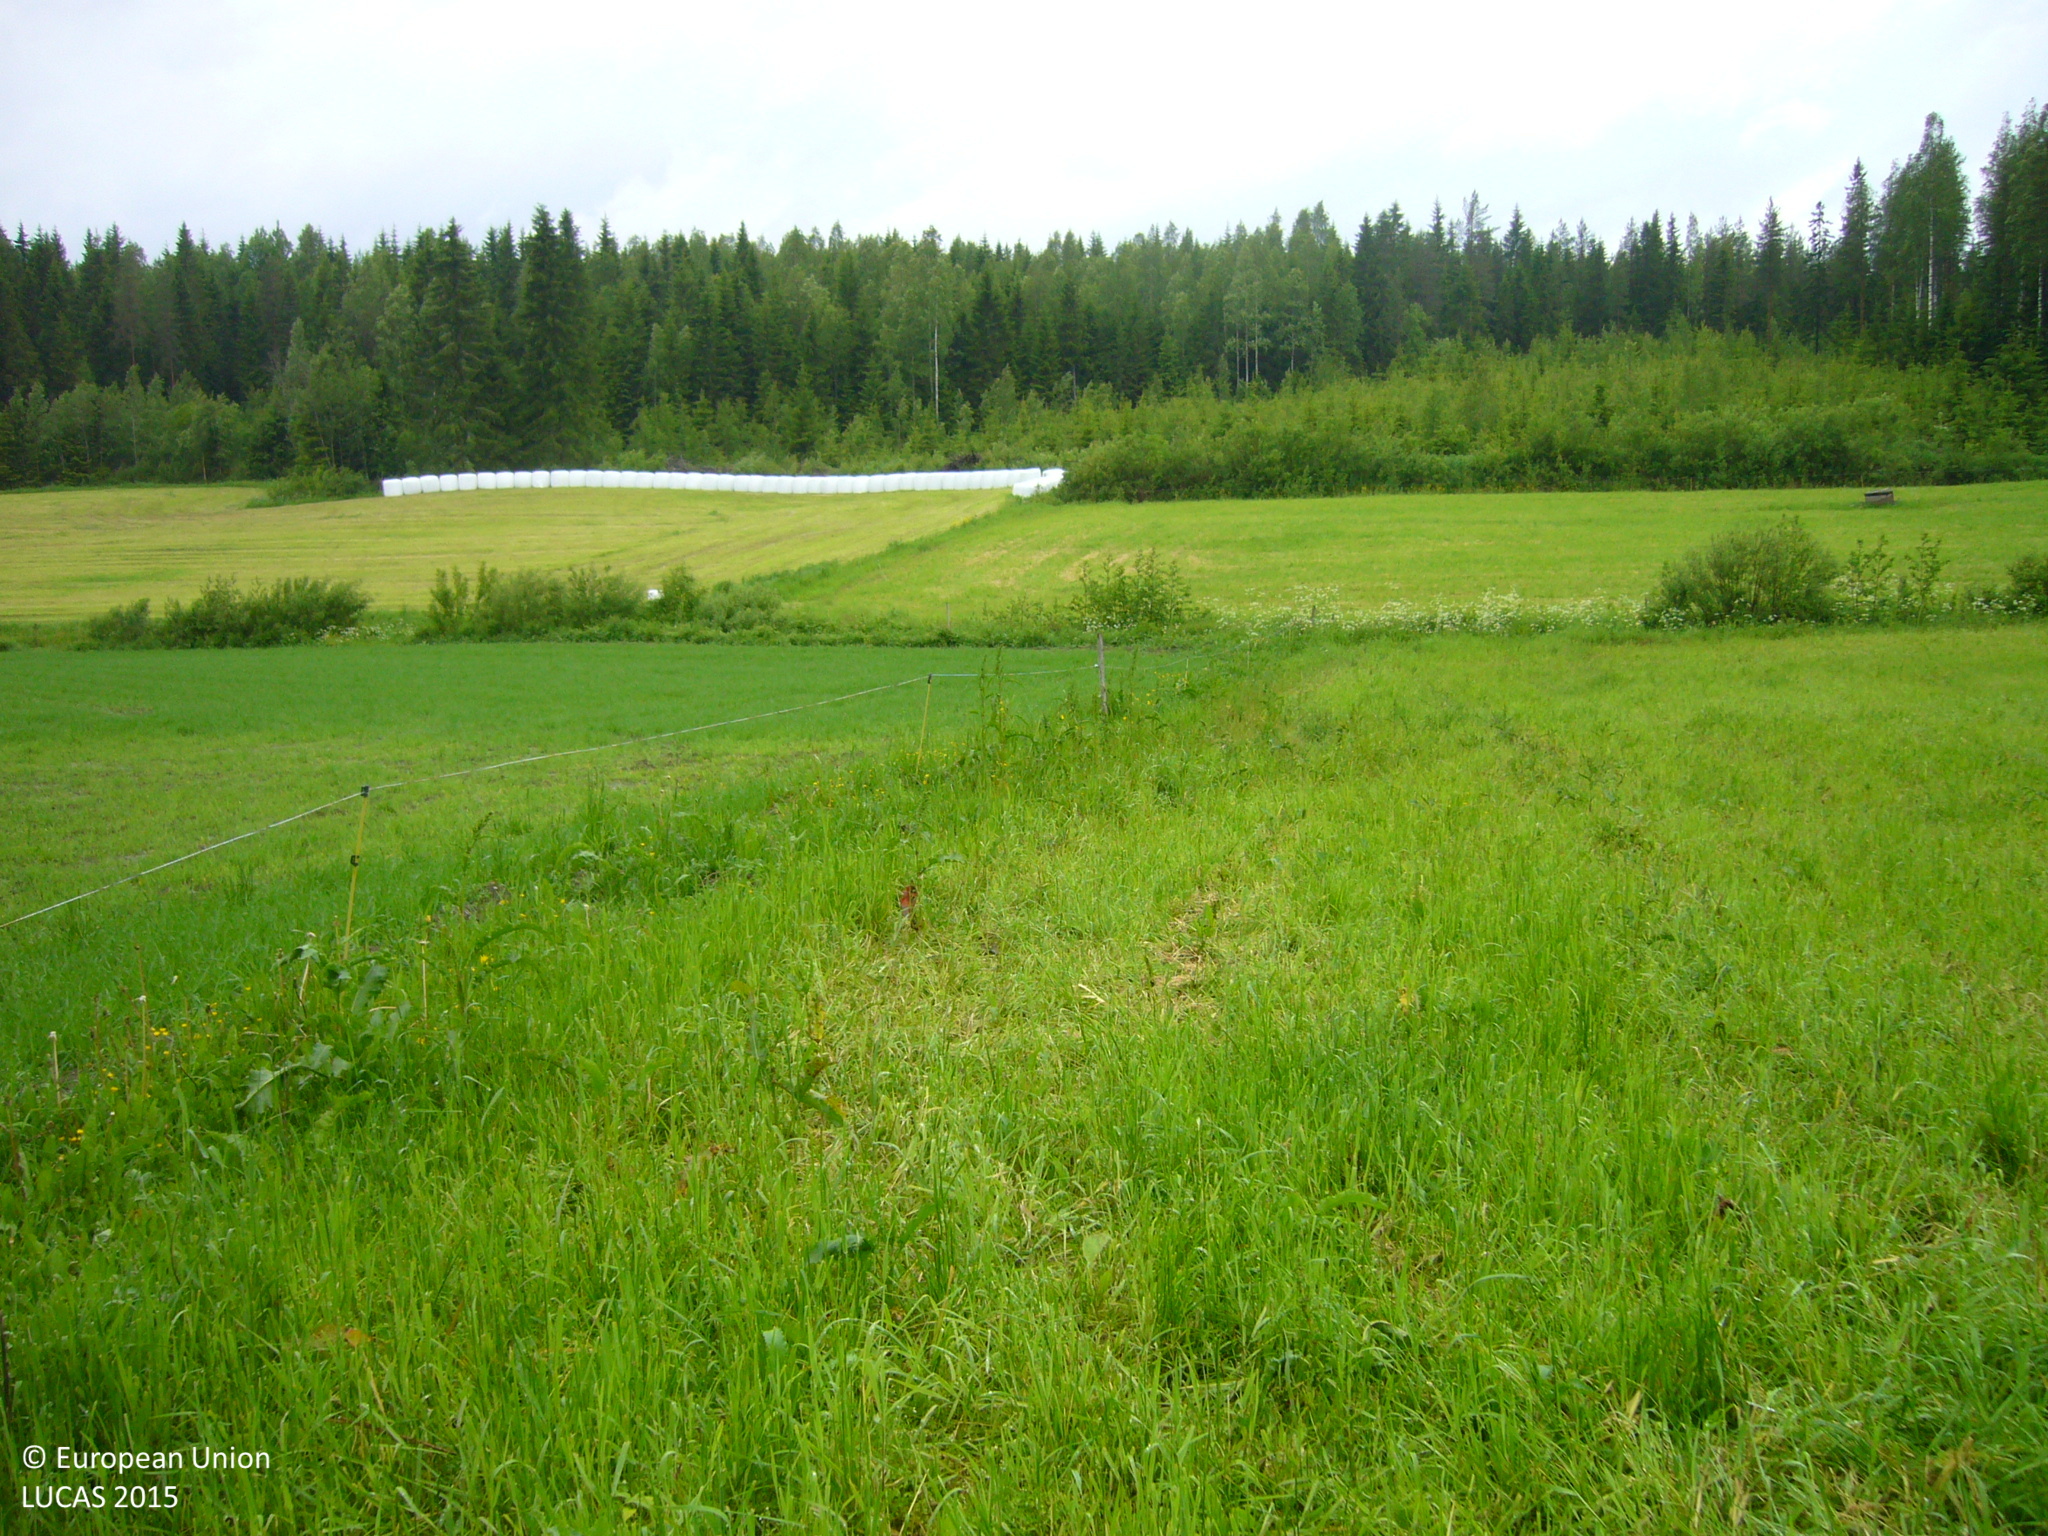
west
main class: Grassland
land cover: Grassland without tree/shrub cover
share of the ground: > 75 %
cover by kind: herbaceous plants 80 %, unconsolidated bare surface 20 %
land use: Agriculture (excluding fallow land and kitchen gardens)
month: June
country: FI
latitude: 63.6236
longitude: 26.4453
